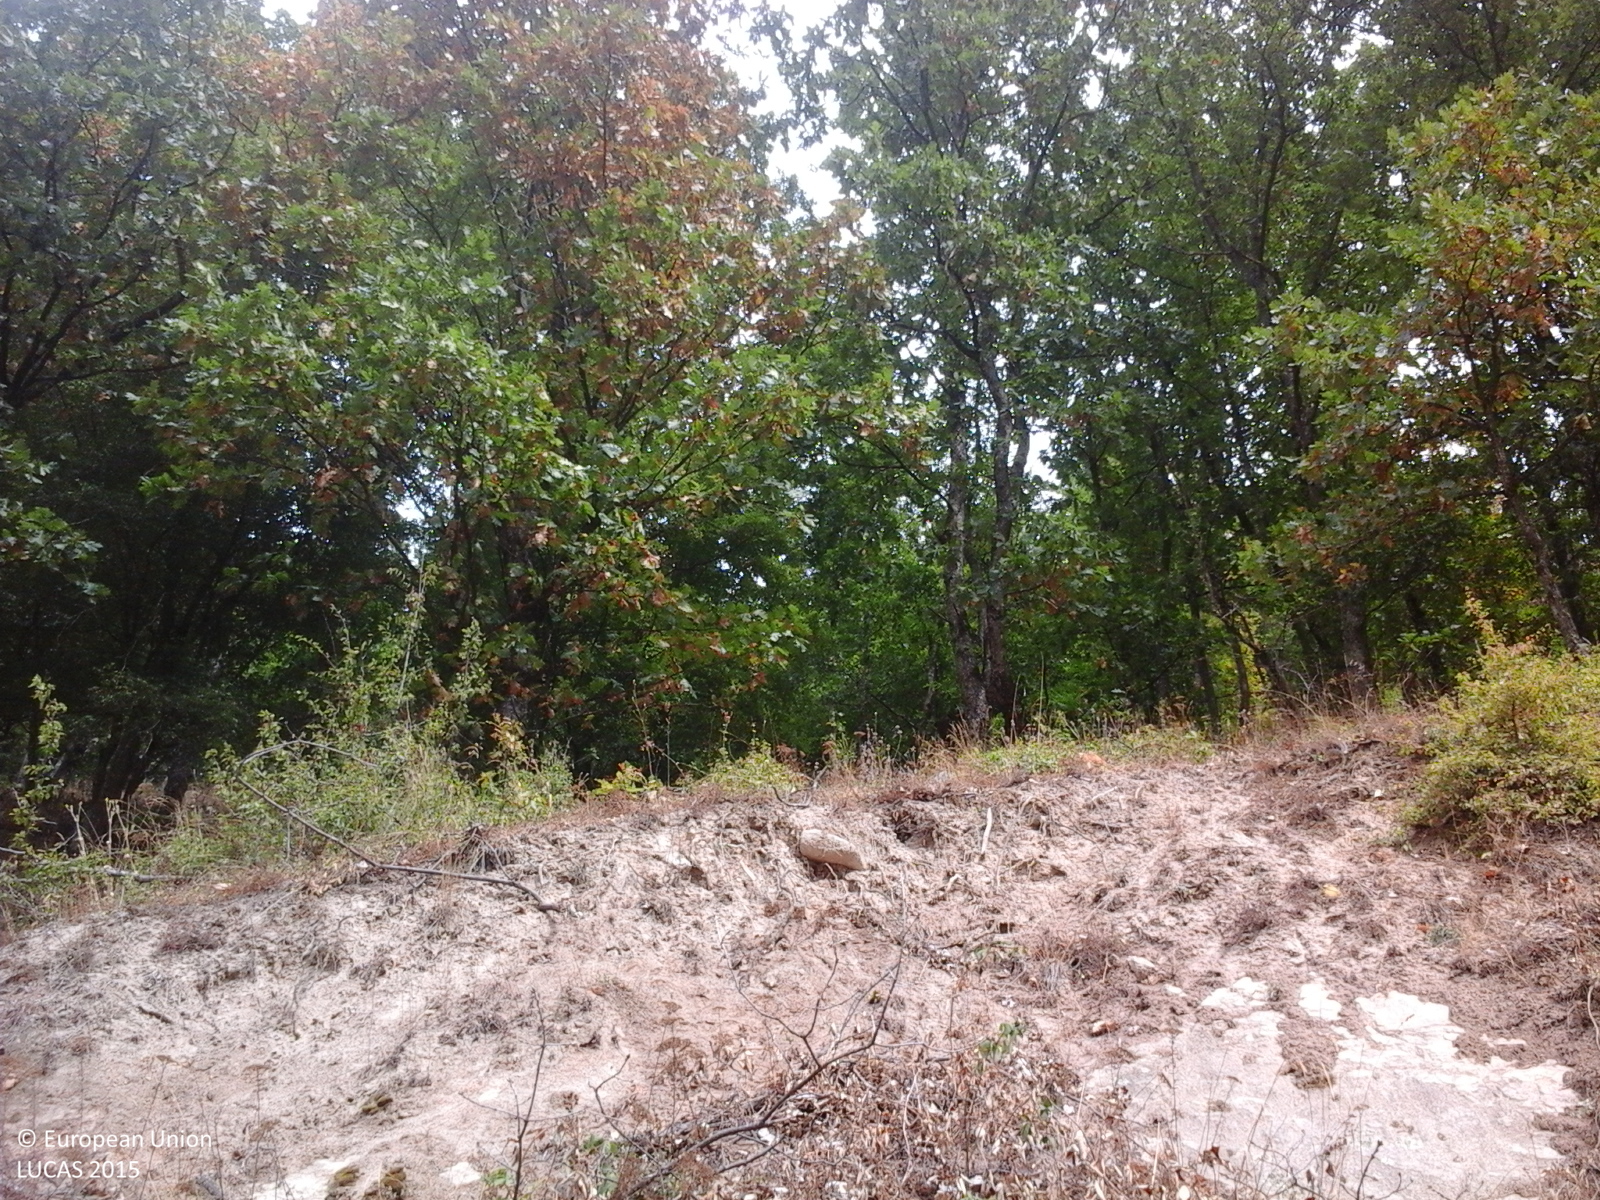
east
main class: Woodland
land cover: Broadleaved woodland
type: acidophilous oak and oak-birch forest
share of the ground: > 75 %
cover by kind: broadleaved forest trees 100 %
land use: Forestry
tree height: > 5 m
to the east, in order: Broadleaved woodland; Ditches and canals; Grassland without tree/shrub cover; Broadleaved woodland
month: August
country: RO
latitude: 44.7267
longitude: 21.8367
